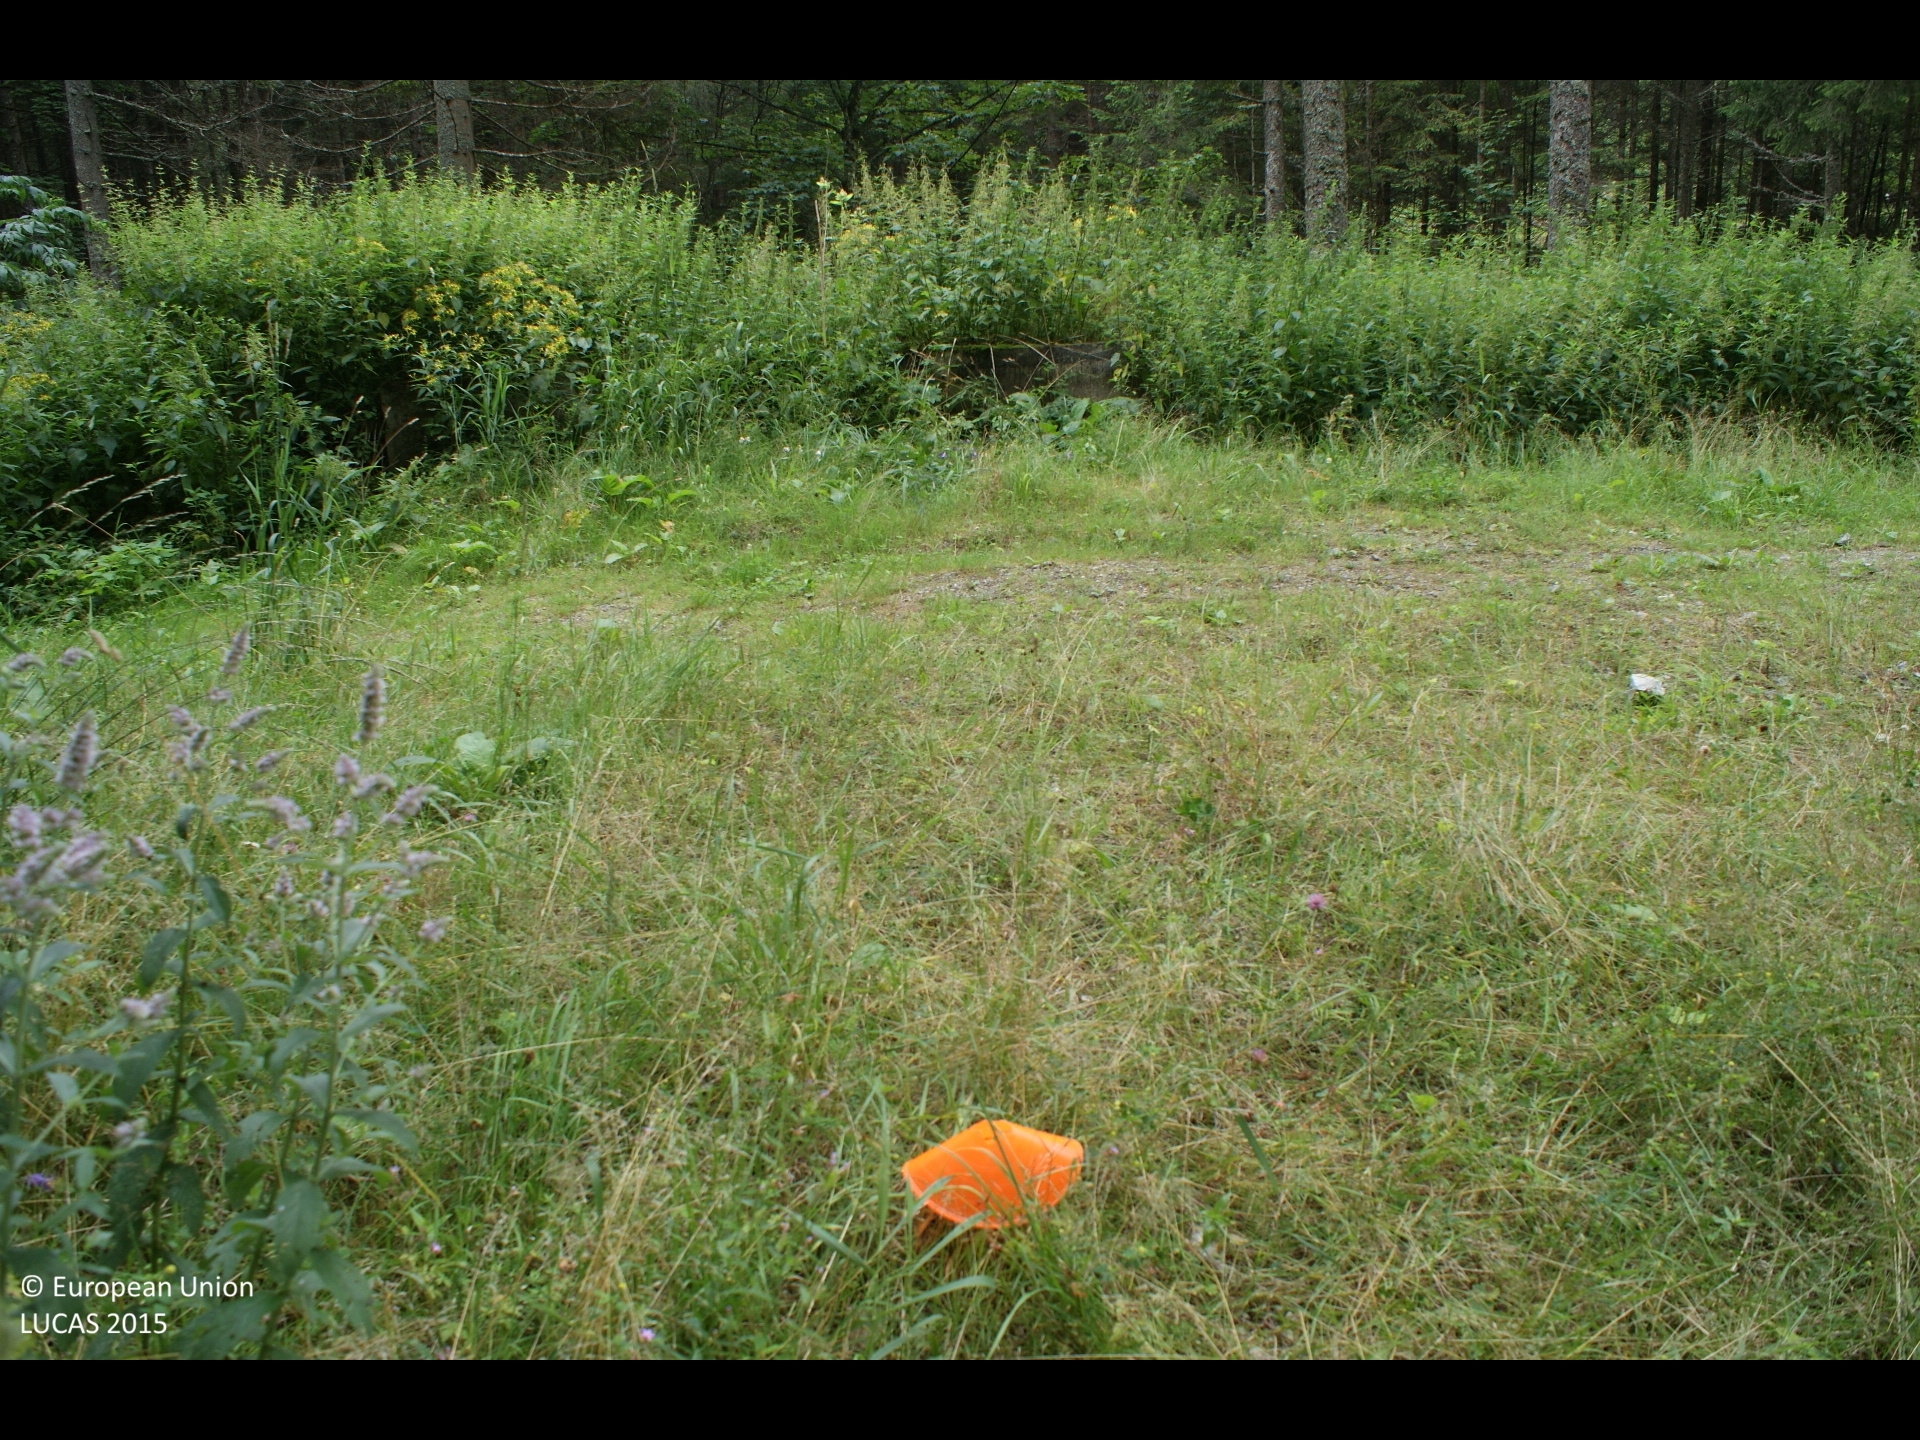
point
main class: Grassland
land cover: Spontaneously vegetated surfaces
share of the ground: > 75 %
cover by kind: herbaceous plants 90 %, unconsolidated bare surface 10 %
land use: Forestry
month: August
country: AT
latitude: 47.6100
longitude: 15.2819
